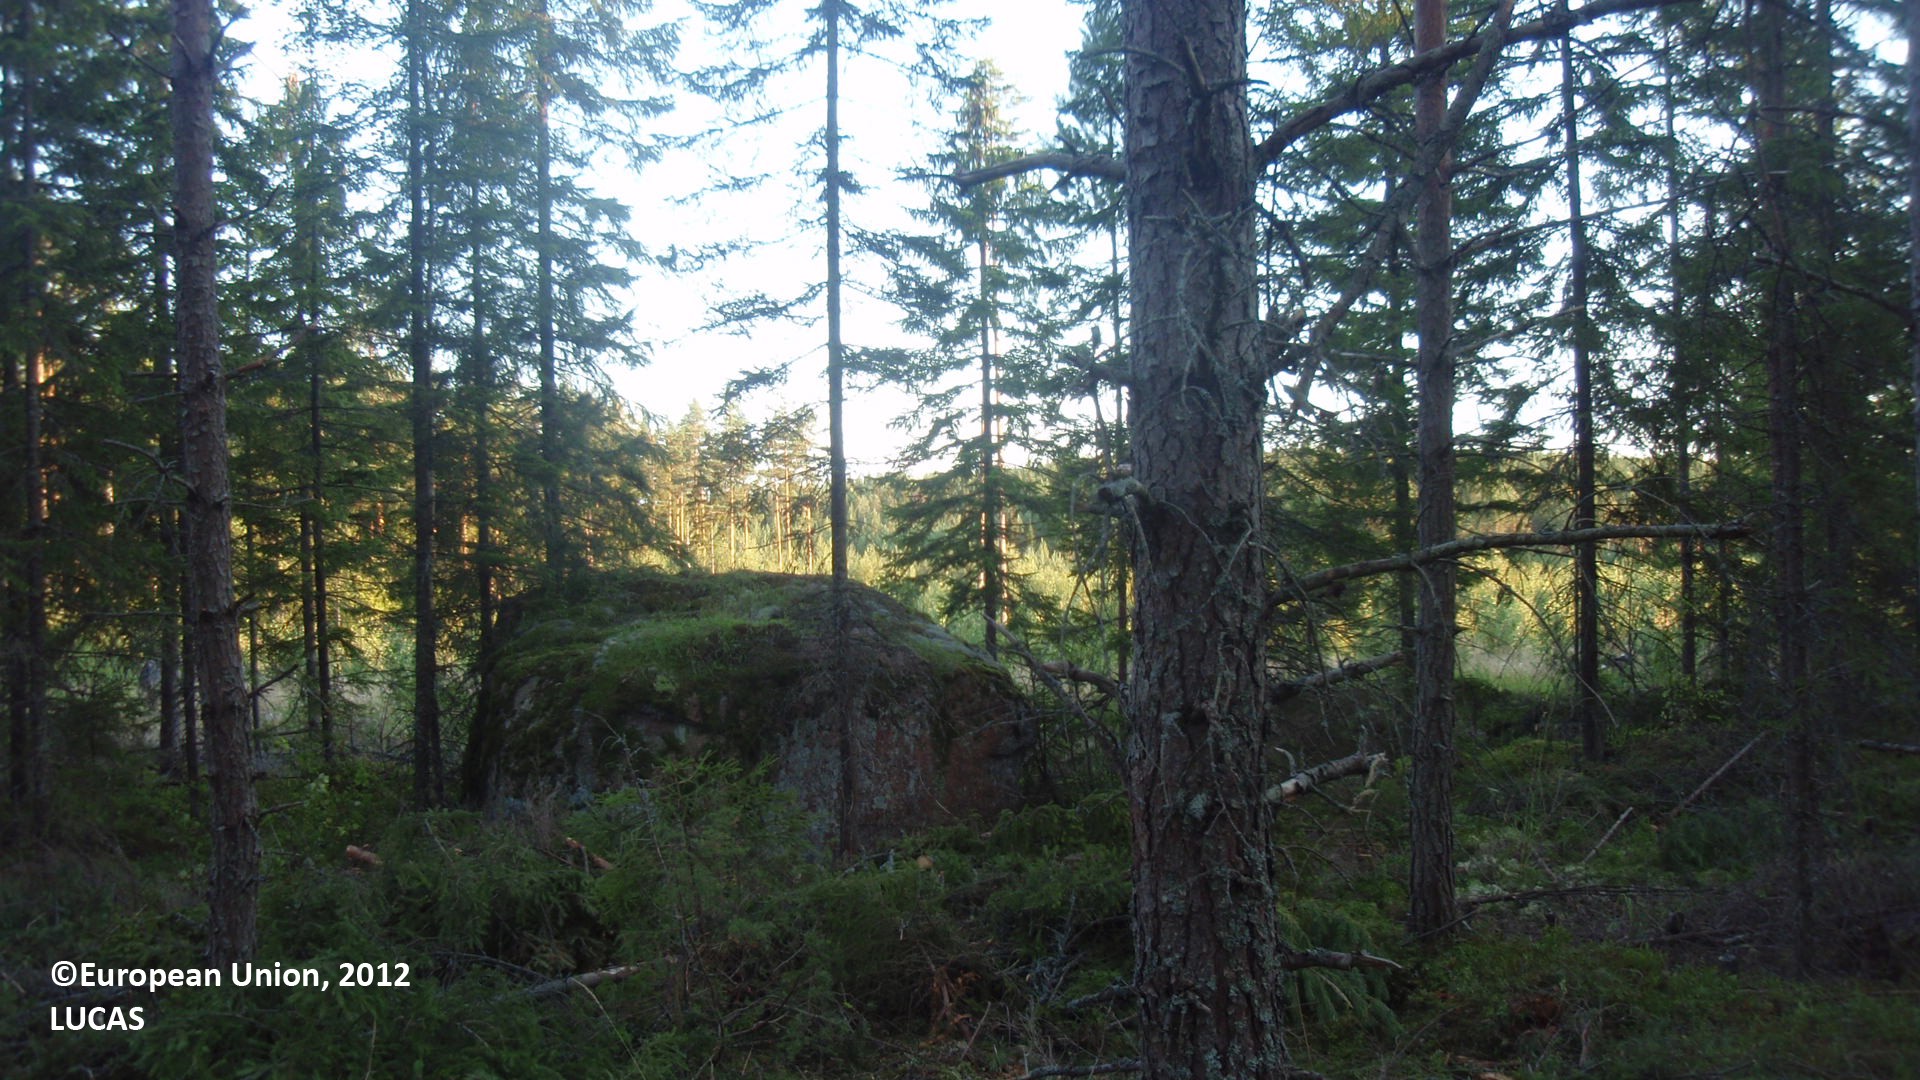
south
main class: Woodland
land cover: Pine dominated coniferous woodland
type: boreal forest
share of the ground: 50 - 75 %
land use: Forestry
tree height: > 5 m
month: August
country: FI
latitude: 60.5292
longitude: 27.4029
